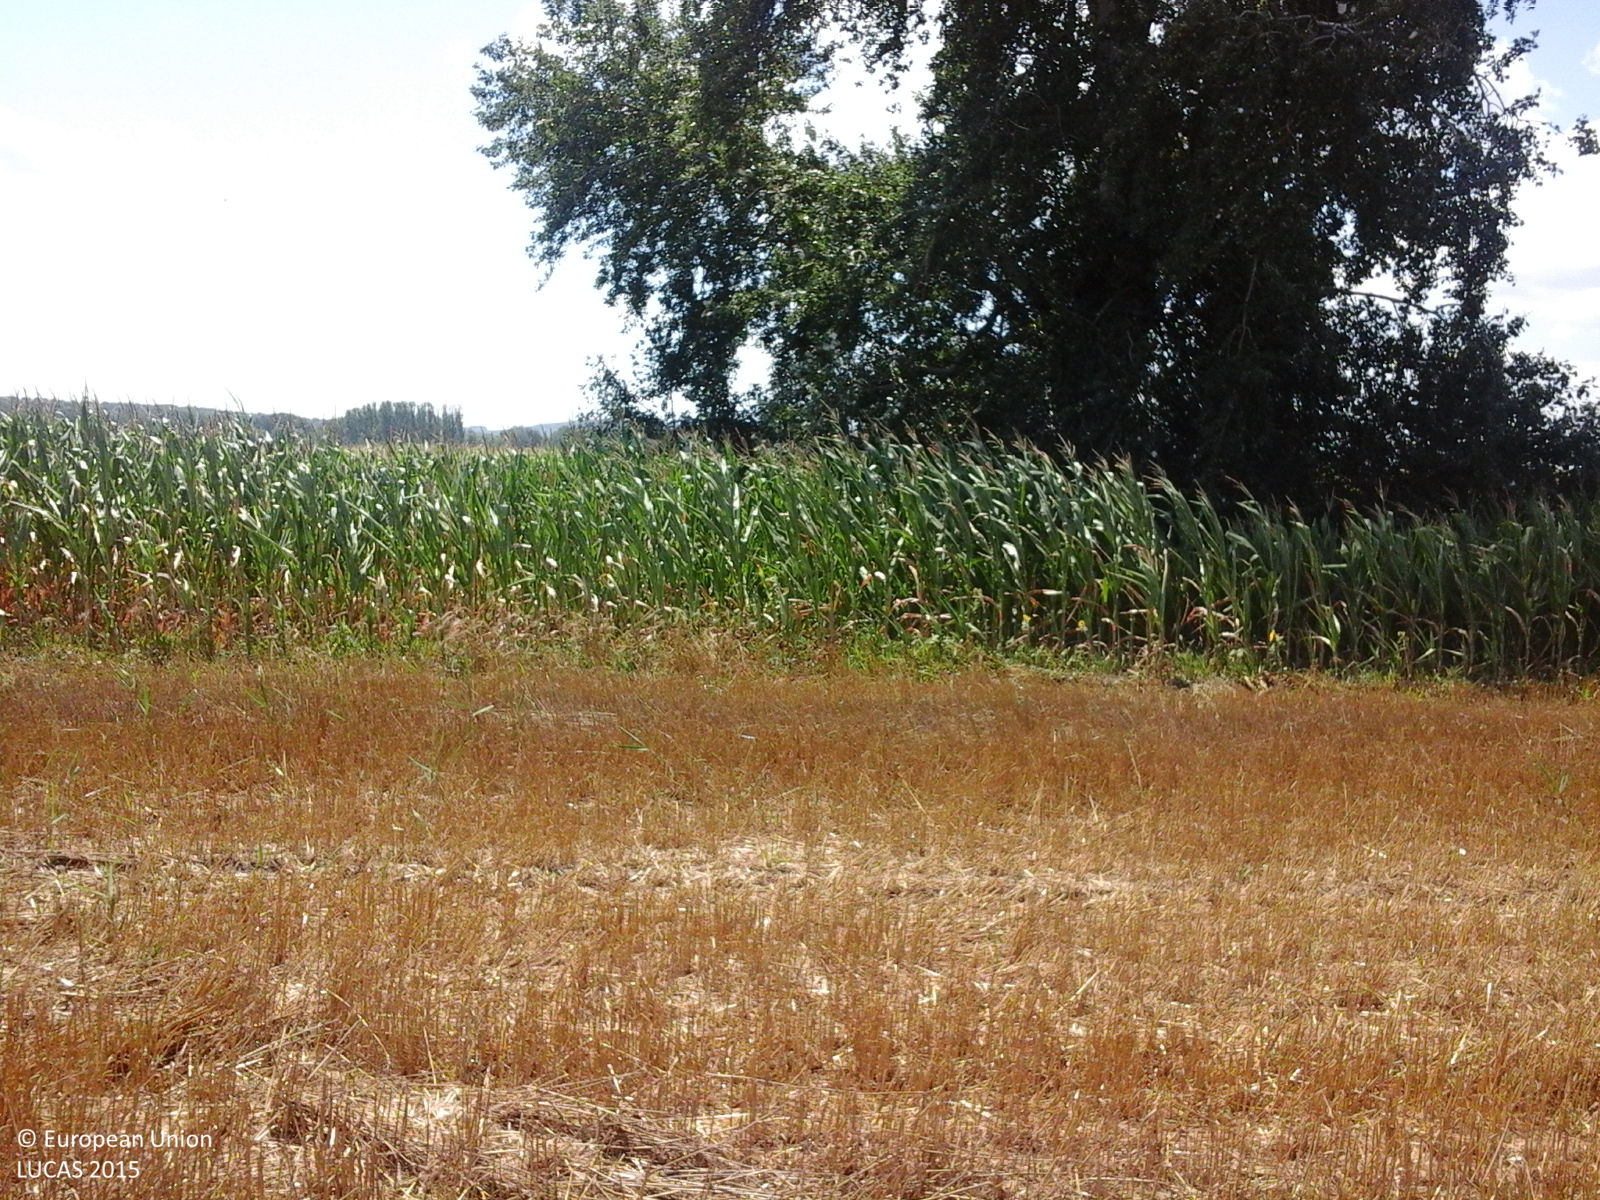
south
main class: Cropland
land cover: Common wheat
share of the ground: 50 - 75 %
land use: Agriculture (excluding fallow land and kitchen gardens)
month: July
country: RO
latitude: 46.4268
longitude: 28.2343
